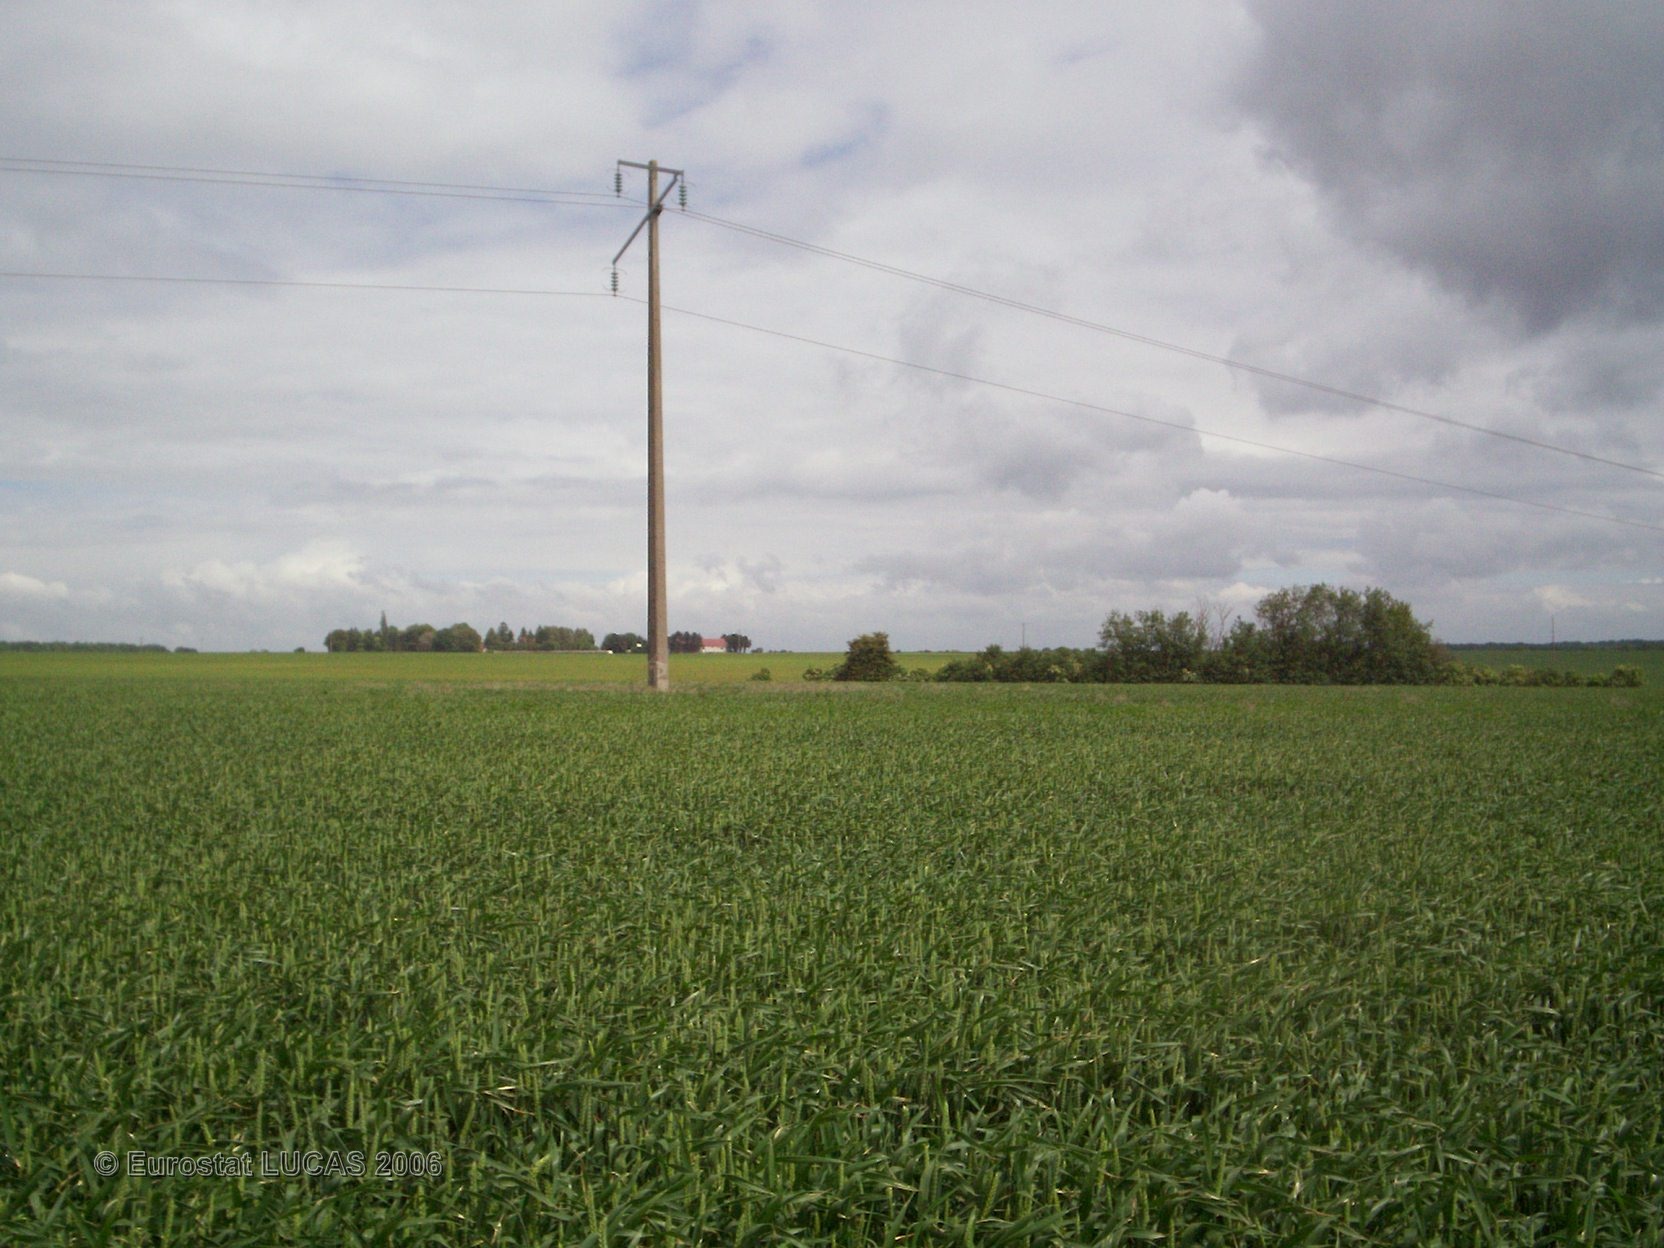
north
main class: Cropland
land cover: Common wheat
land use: Agriculture (excluding fallow land and kitchen gardens)
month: May
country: FR
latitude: 49.2866
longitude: 2.7719
